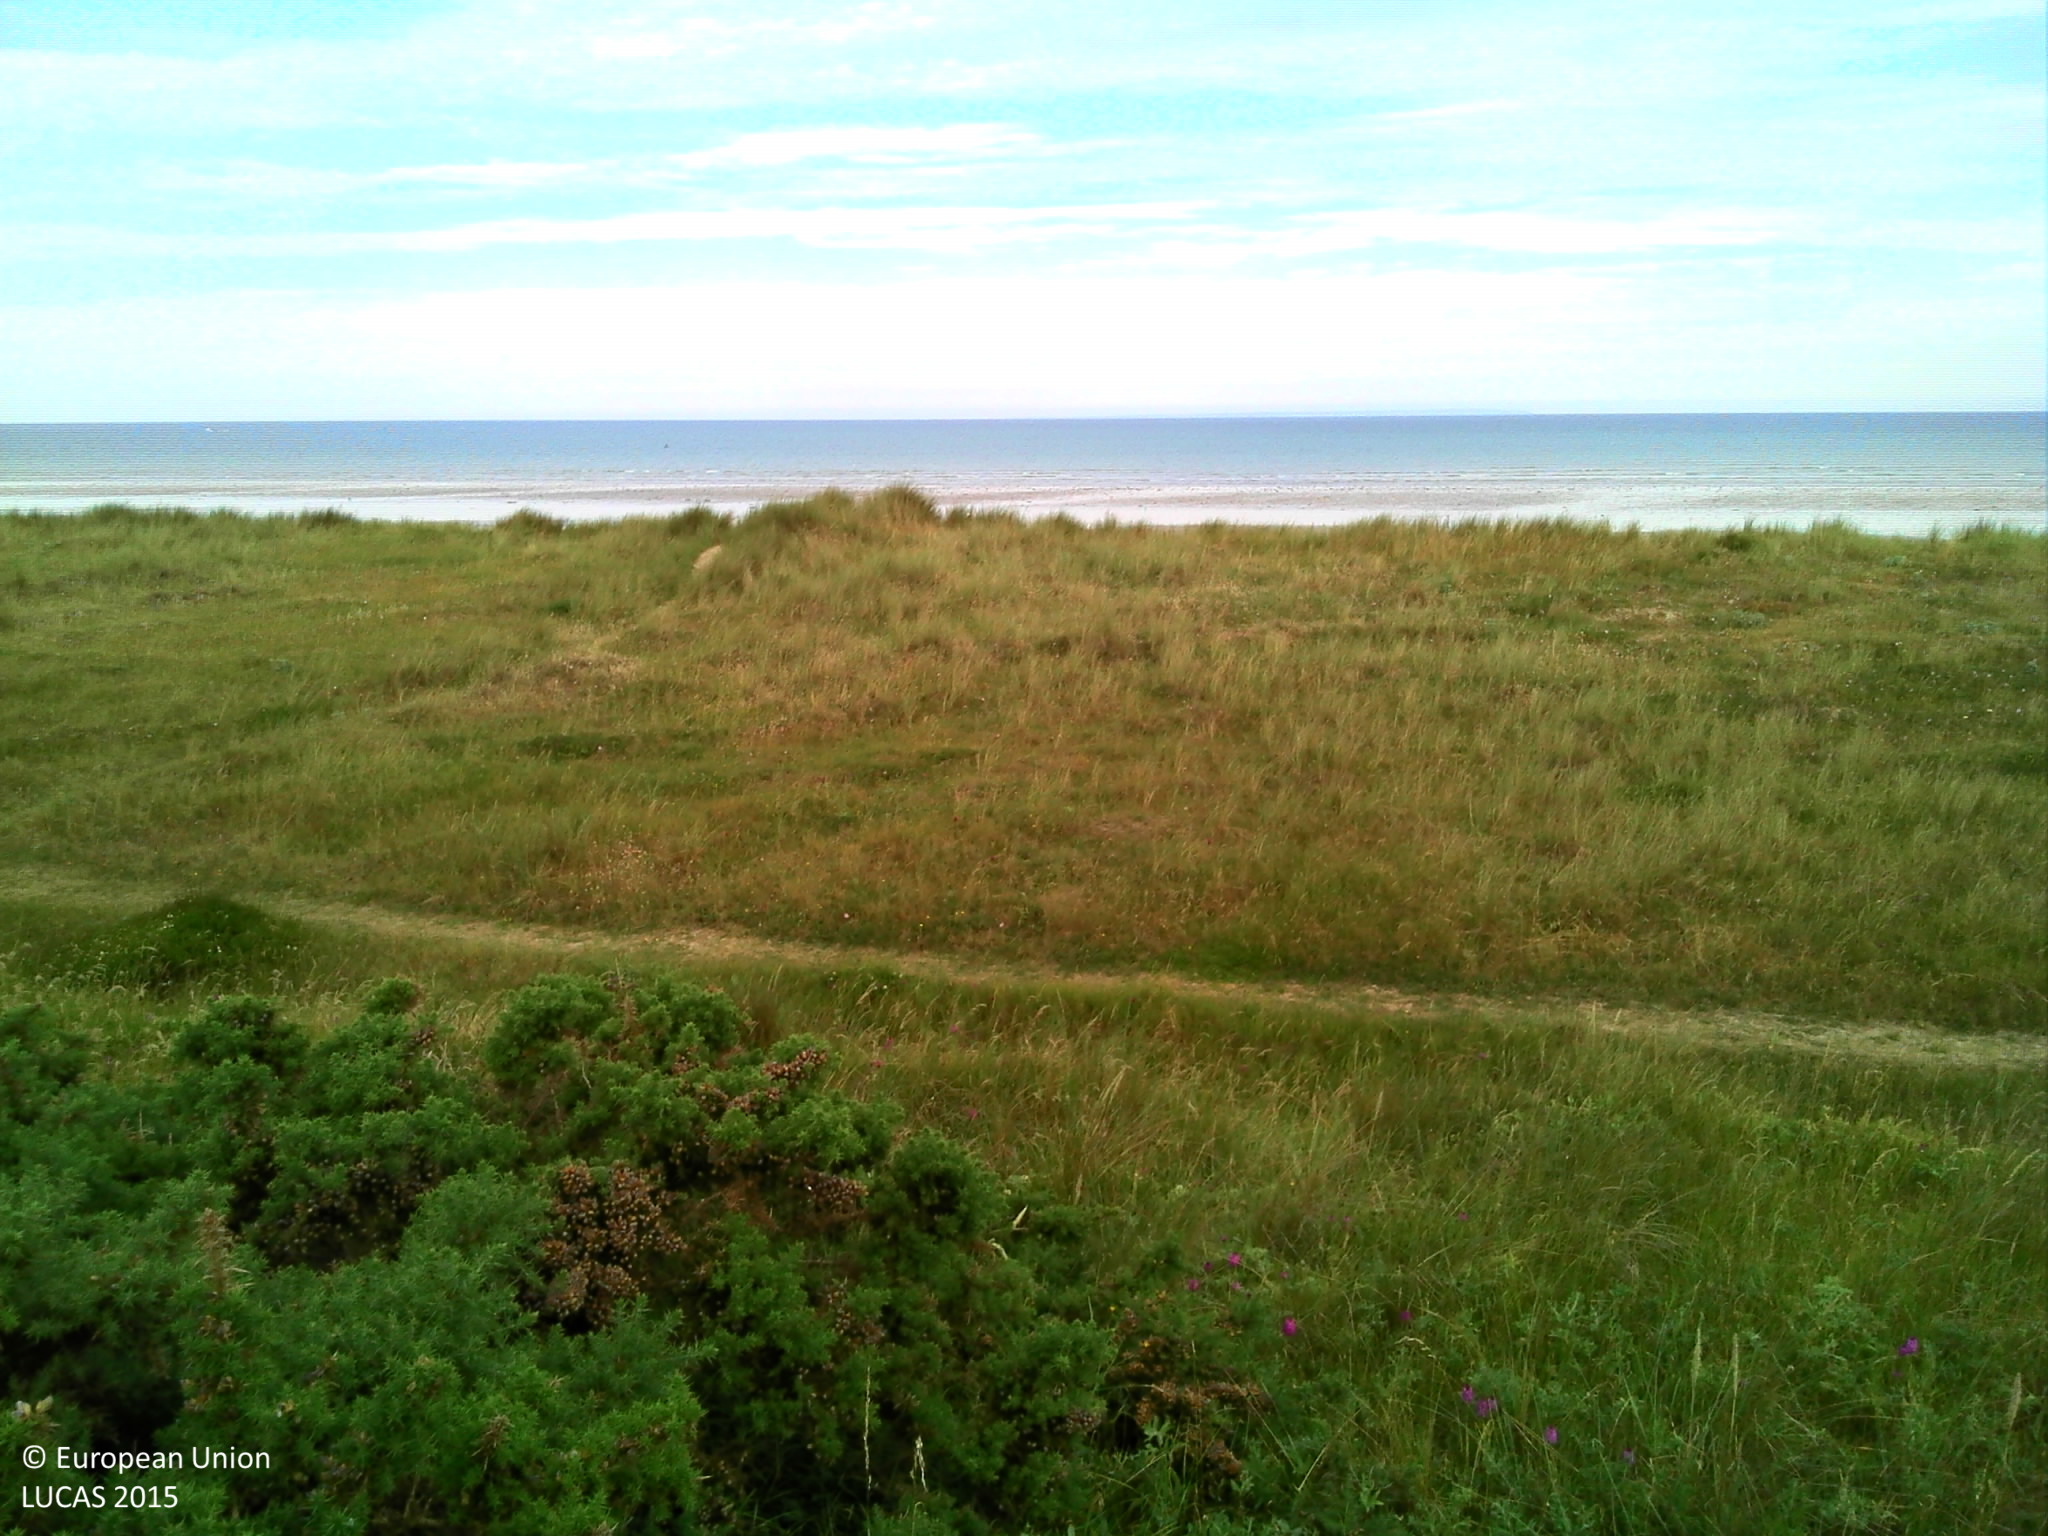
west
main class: Shrubland
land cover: Shrubland without tree cover
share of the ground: > 75 %
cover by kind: unconsolidated bare surface 70 %, herbaceous plants 20 %, shrubs 10 %
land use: Semi-natural and natural areas not in use
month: June
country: FR
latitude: 49.1174
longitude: -1.6001
